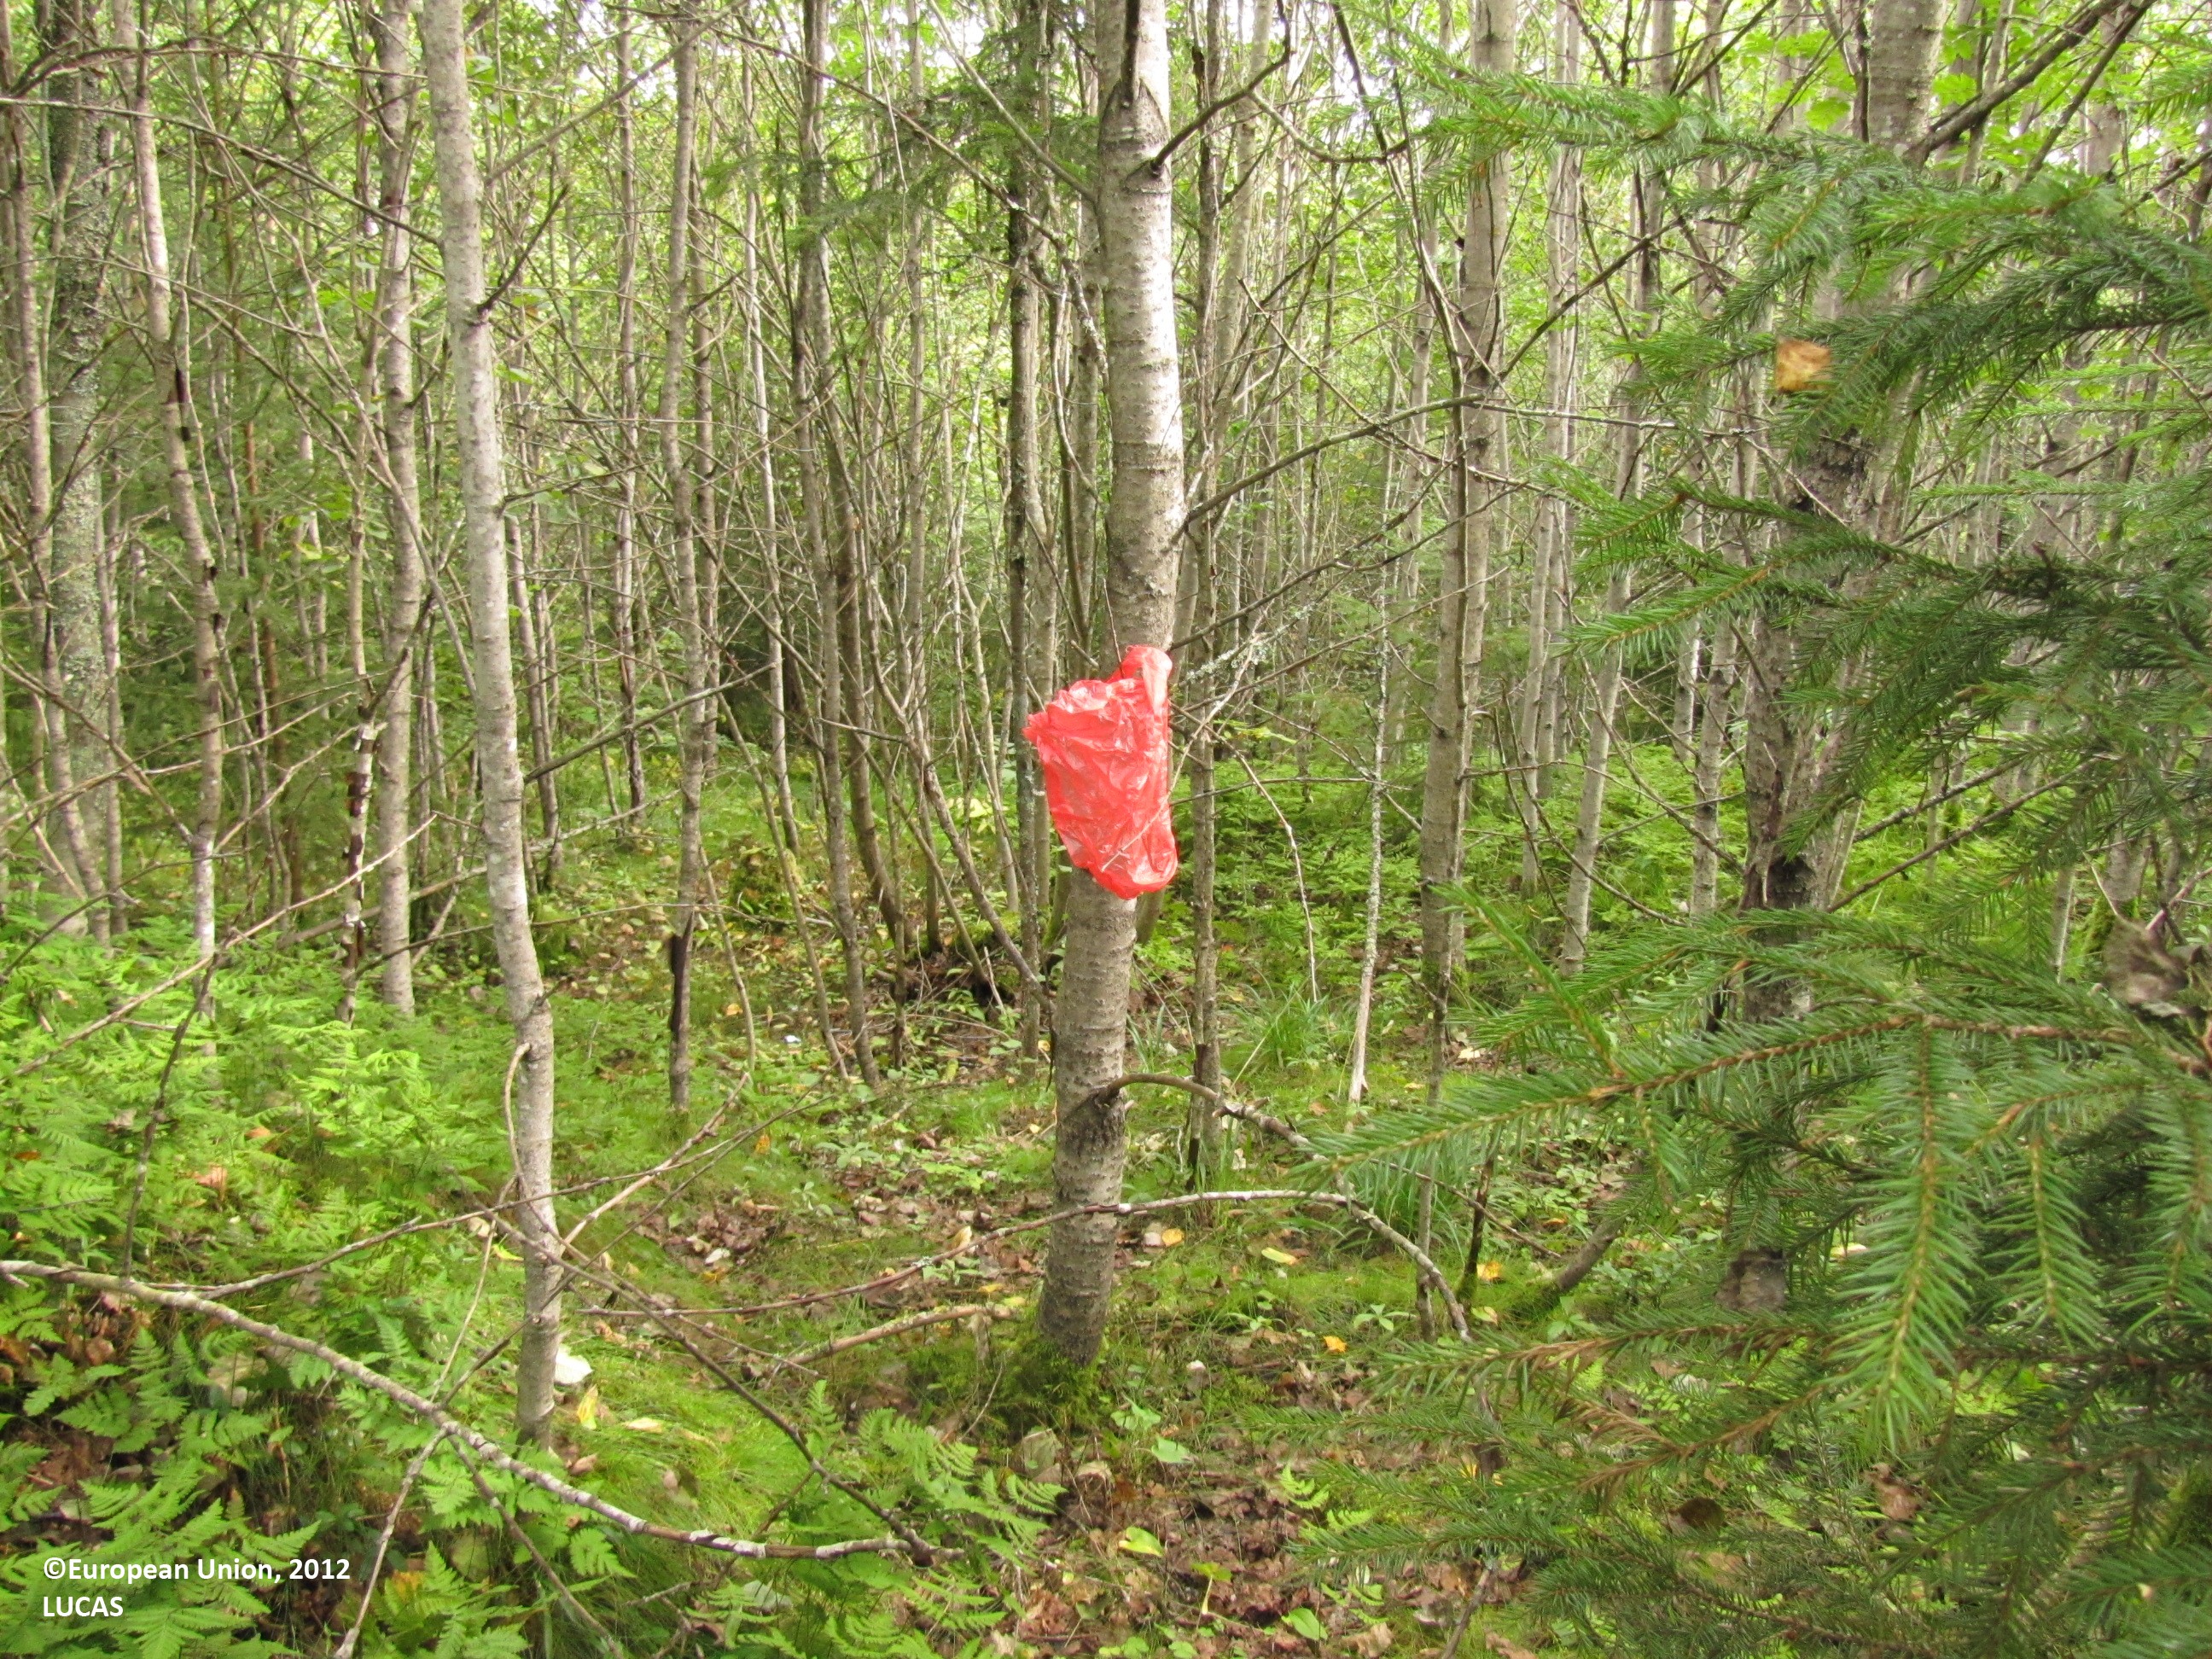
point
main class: Woodland
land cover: Broadleaved woodland
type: boreal forest
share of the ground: > 75 %
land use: Forestry
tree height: > 5 m
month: August
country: FI
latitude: 61.8858
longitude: 22.9455
